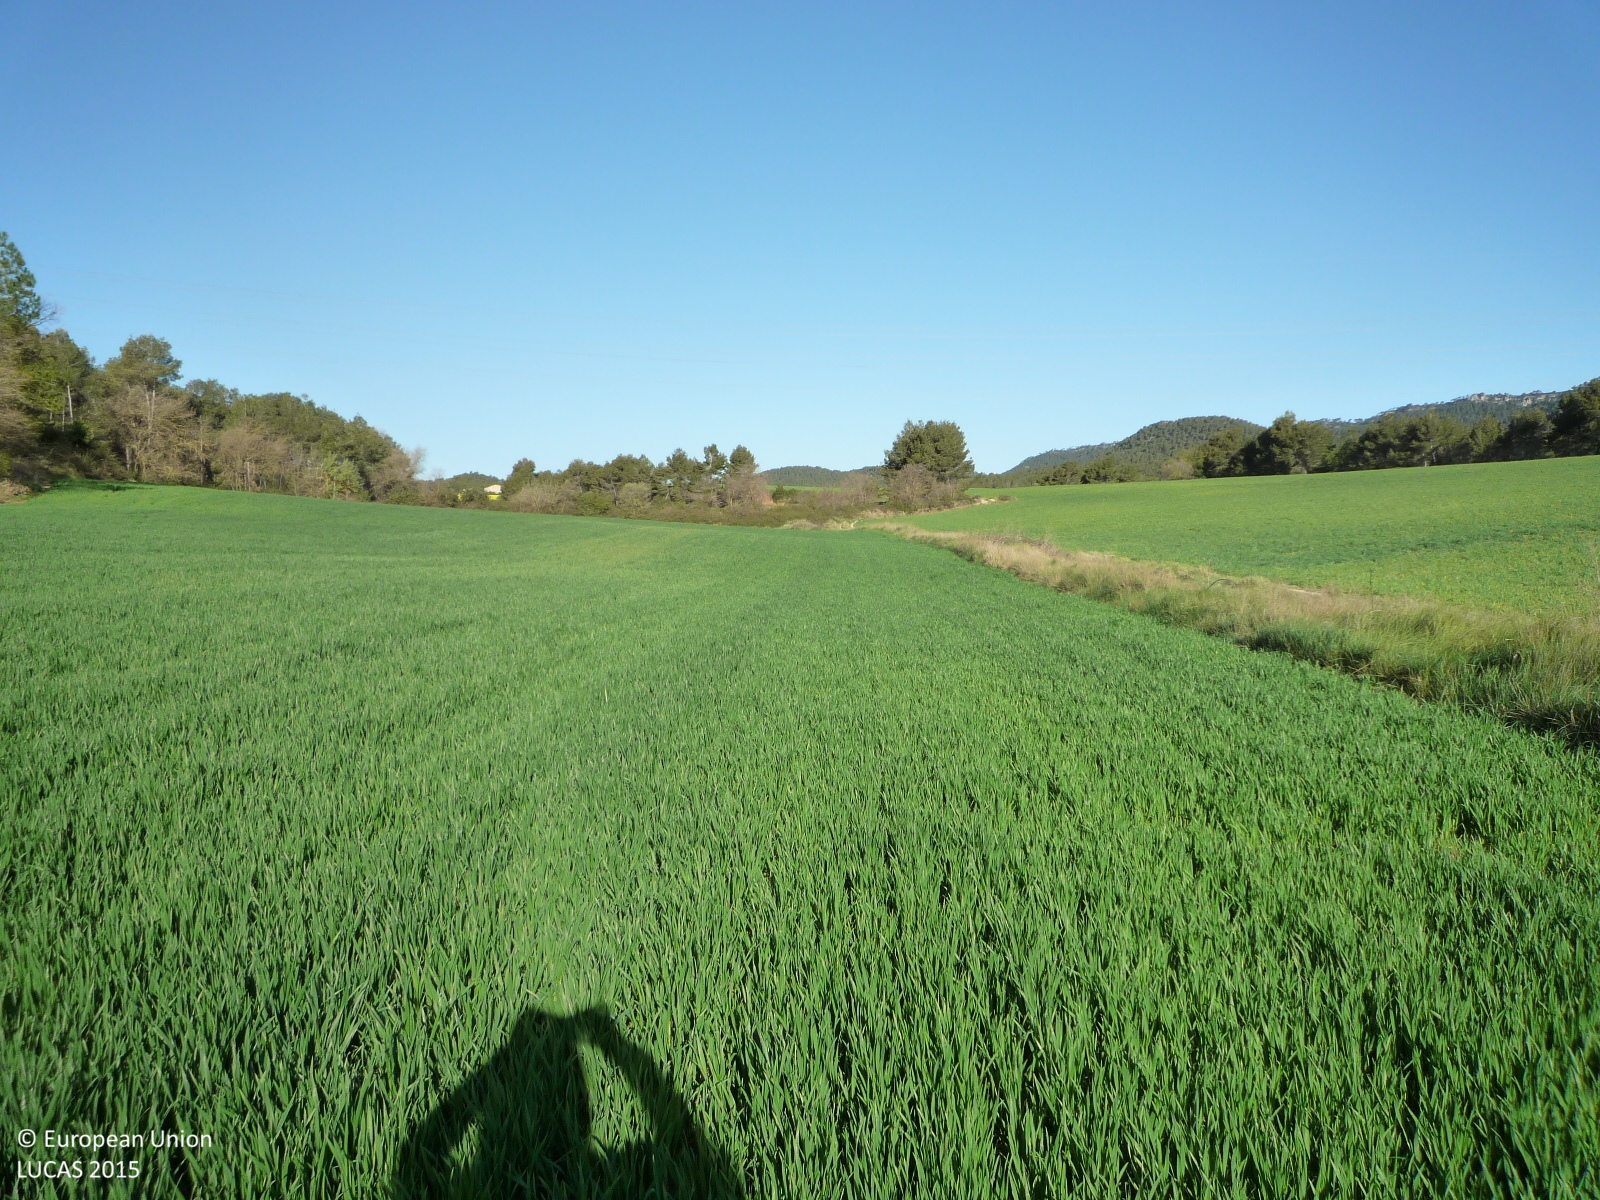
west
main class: Cropland
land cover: Common wheat
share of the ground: > 75 %
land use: Agriculture (excluding fallow land and kitchen gardens)
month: April
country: ES
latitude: 41.4972
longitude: 1.4988
